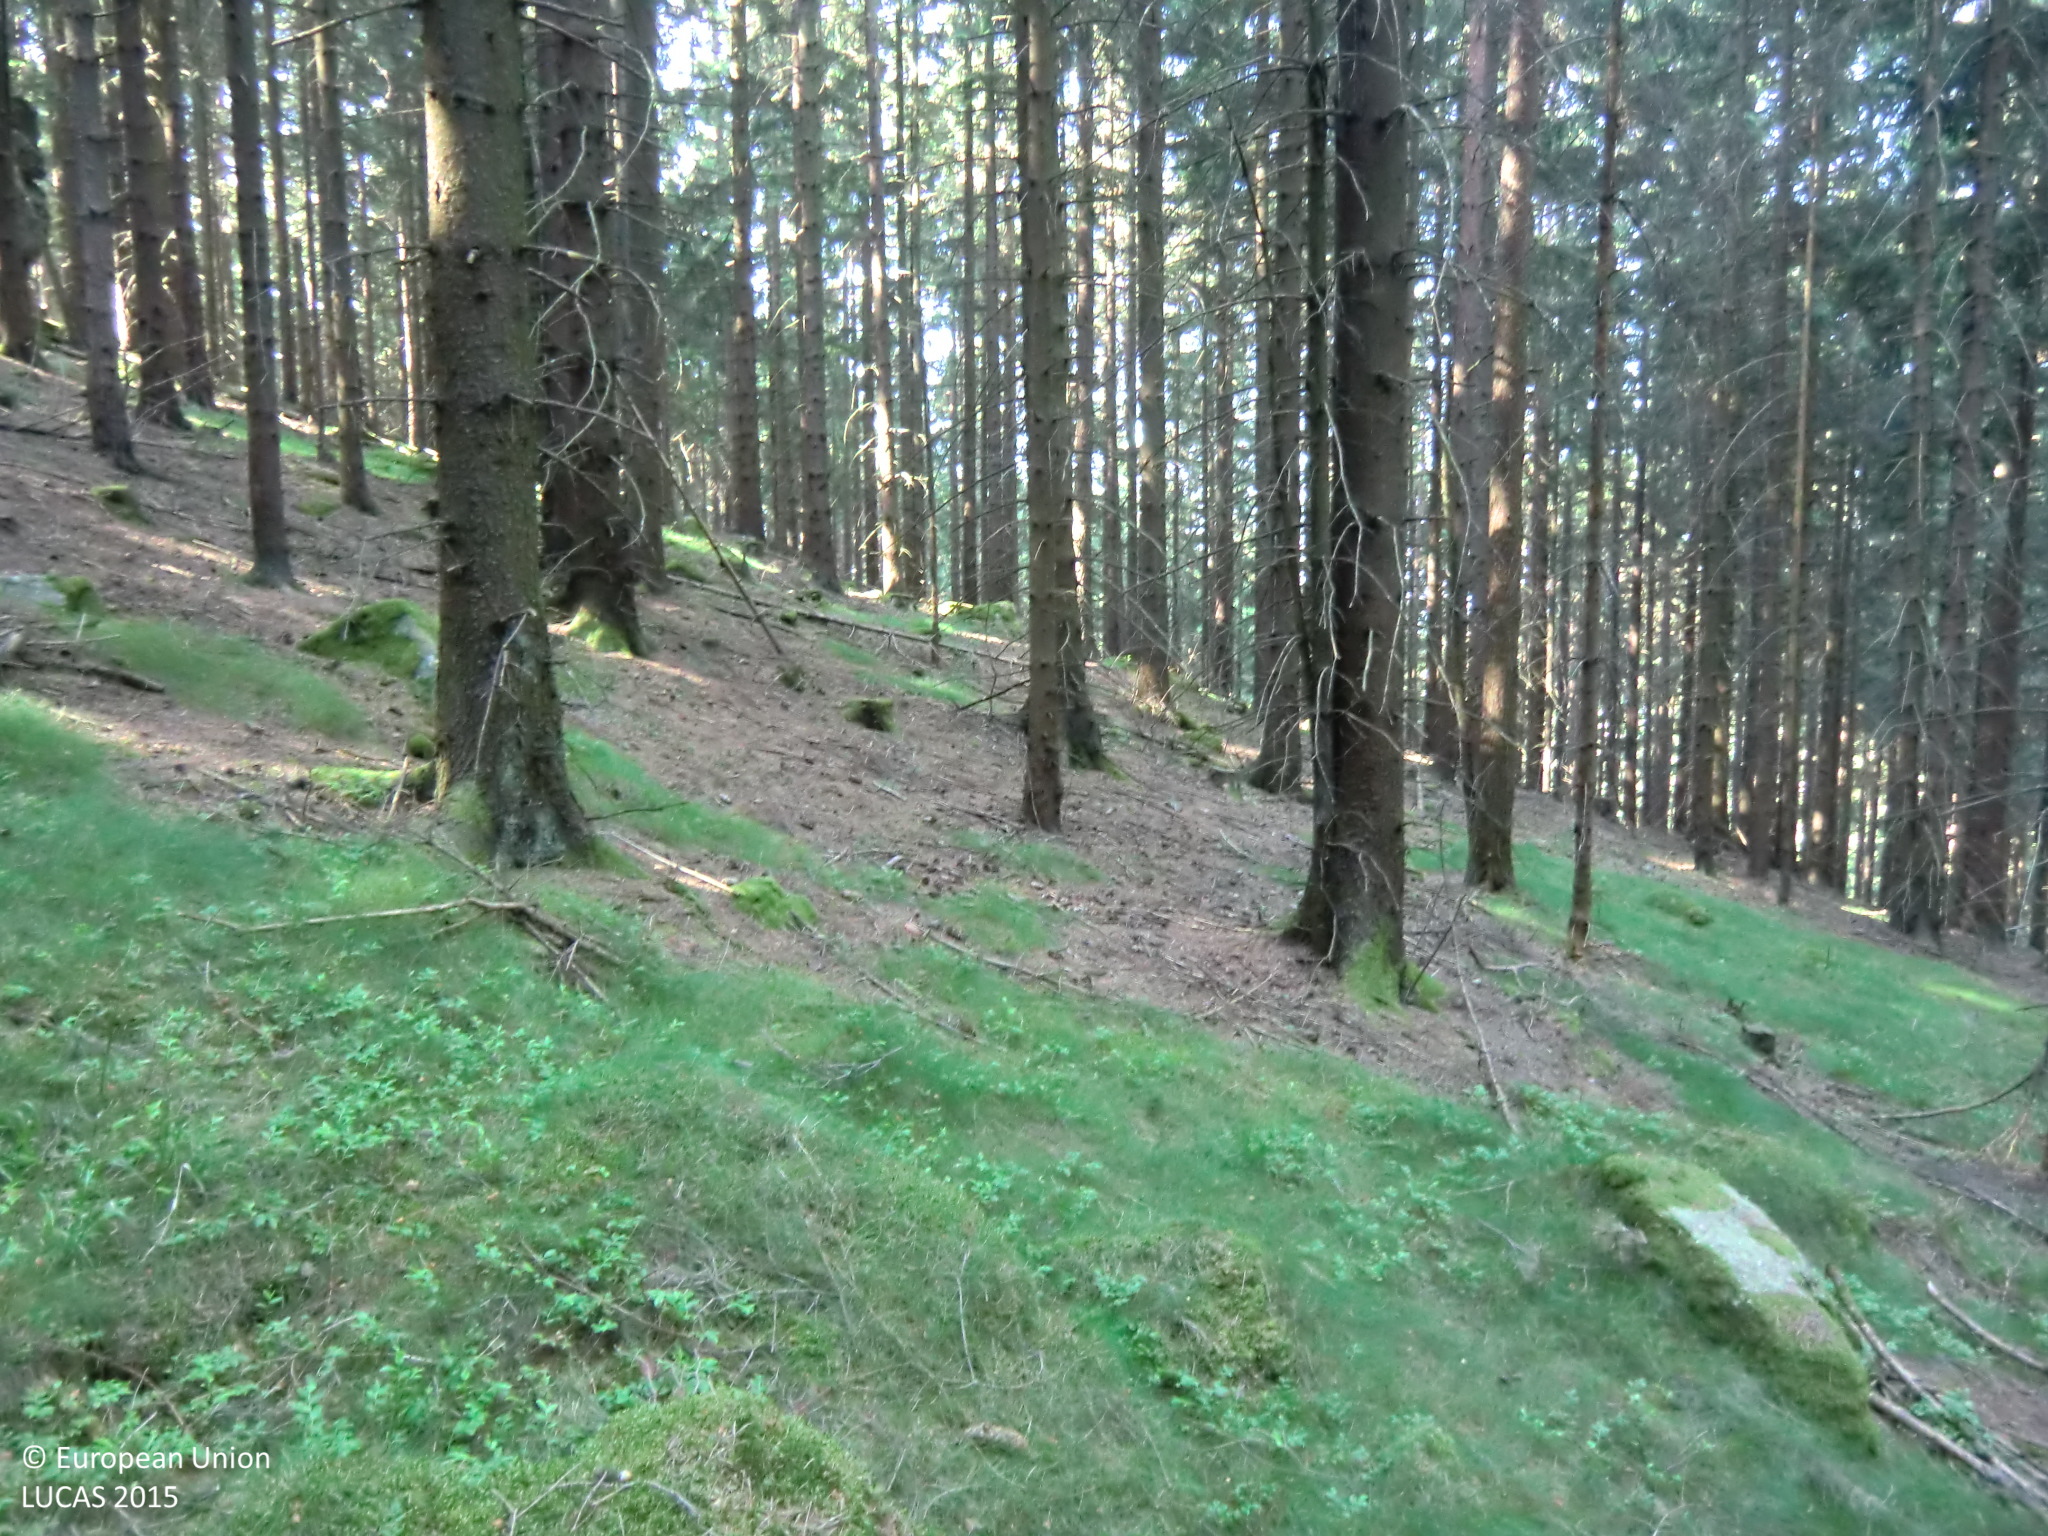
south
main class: Woodland
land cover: Spruce dominated coniferous woodland
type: hemiboreal forest and nemoral coniferous forest and mixed broadleaved-coniferous forest
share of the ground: > 75 %
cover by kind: coniferous forest trees 80 %, herbaceous plants 10 %, lichens and mosses 5 %, unconsolidated bare surface 5 %
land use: Forestry
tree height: > 5 m
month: June
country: AT
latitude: 48.4603
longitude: 14.3955
